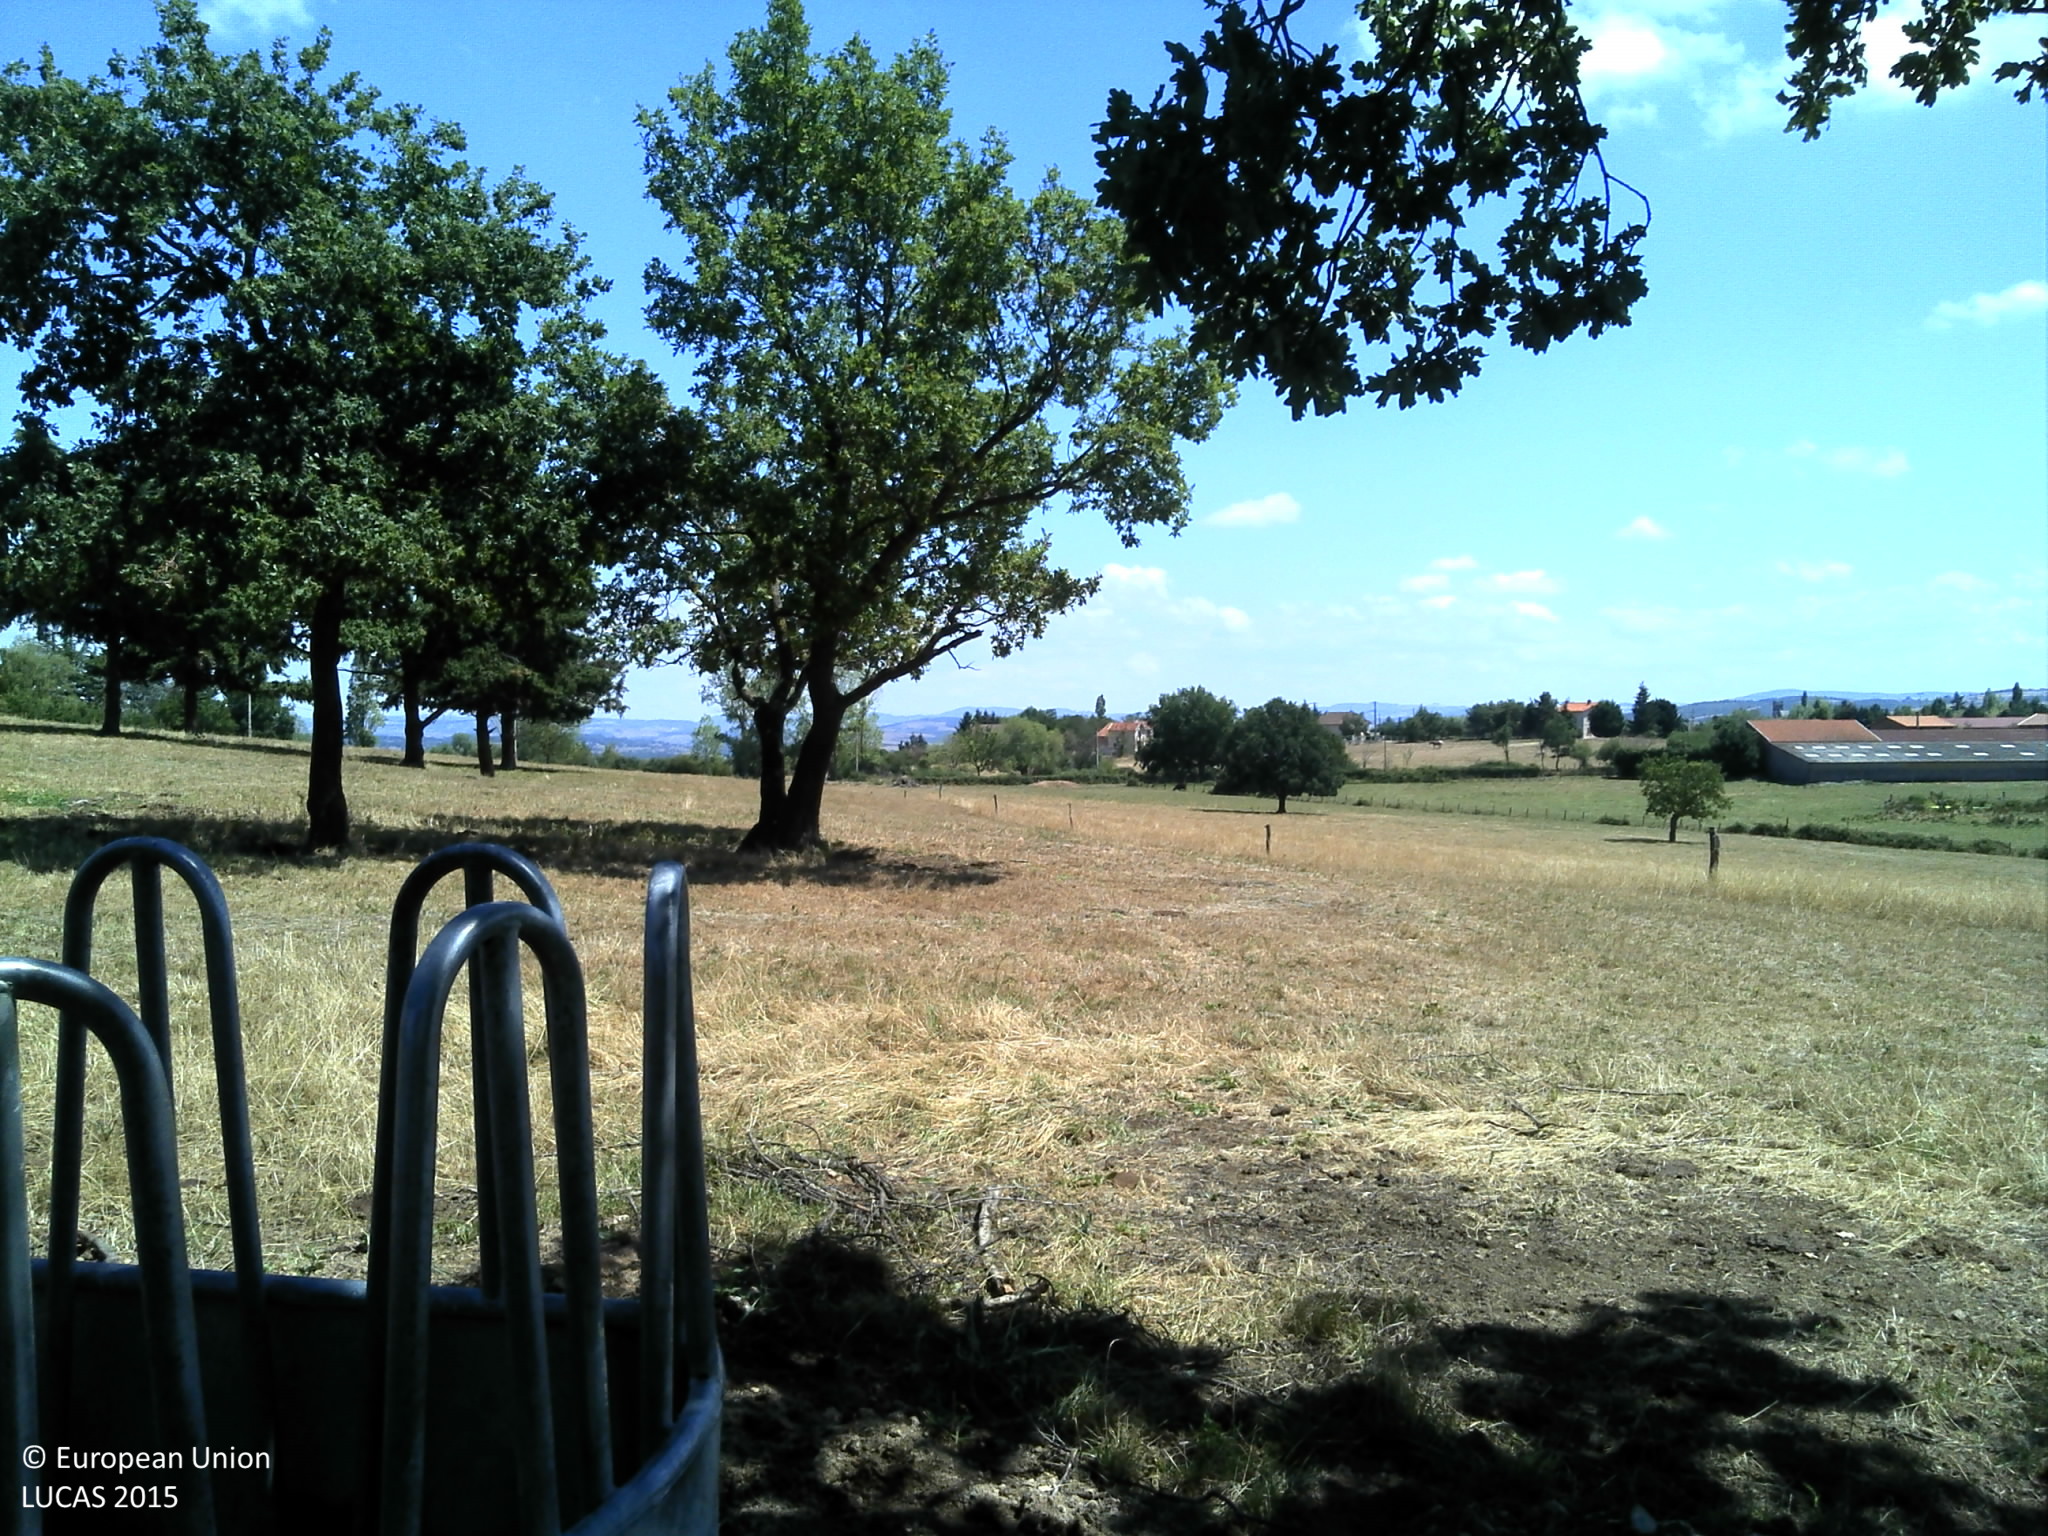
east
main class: Grassland
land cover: Grassland without tree/shrub cover
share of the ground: > 75 %
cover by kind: herbaceous plants 100 %
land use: Agriculture (excluding fallow land and kitchen gardens)
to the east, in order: Grassland without tree/shrub cover; Fences; Grassland without tree/shrub cover
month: July
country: FR
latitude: 45.9704
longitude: 4.0782
